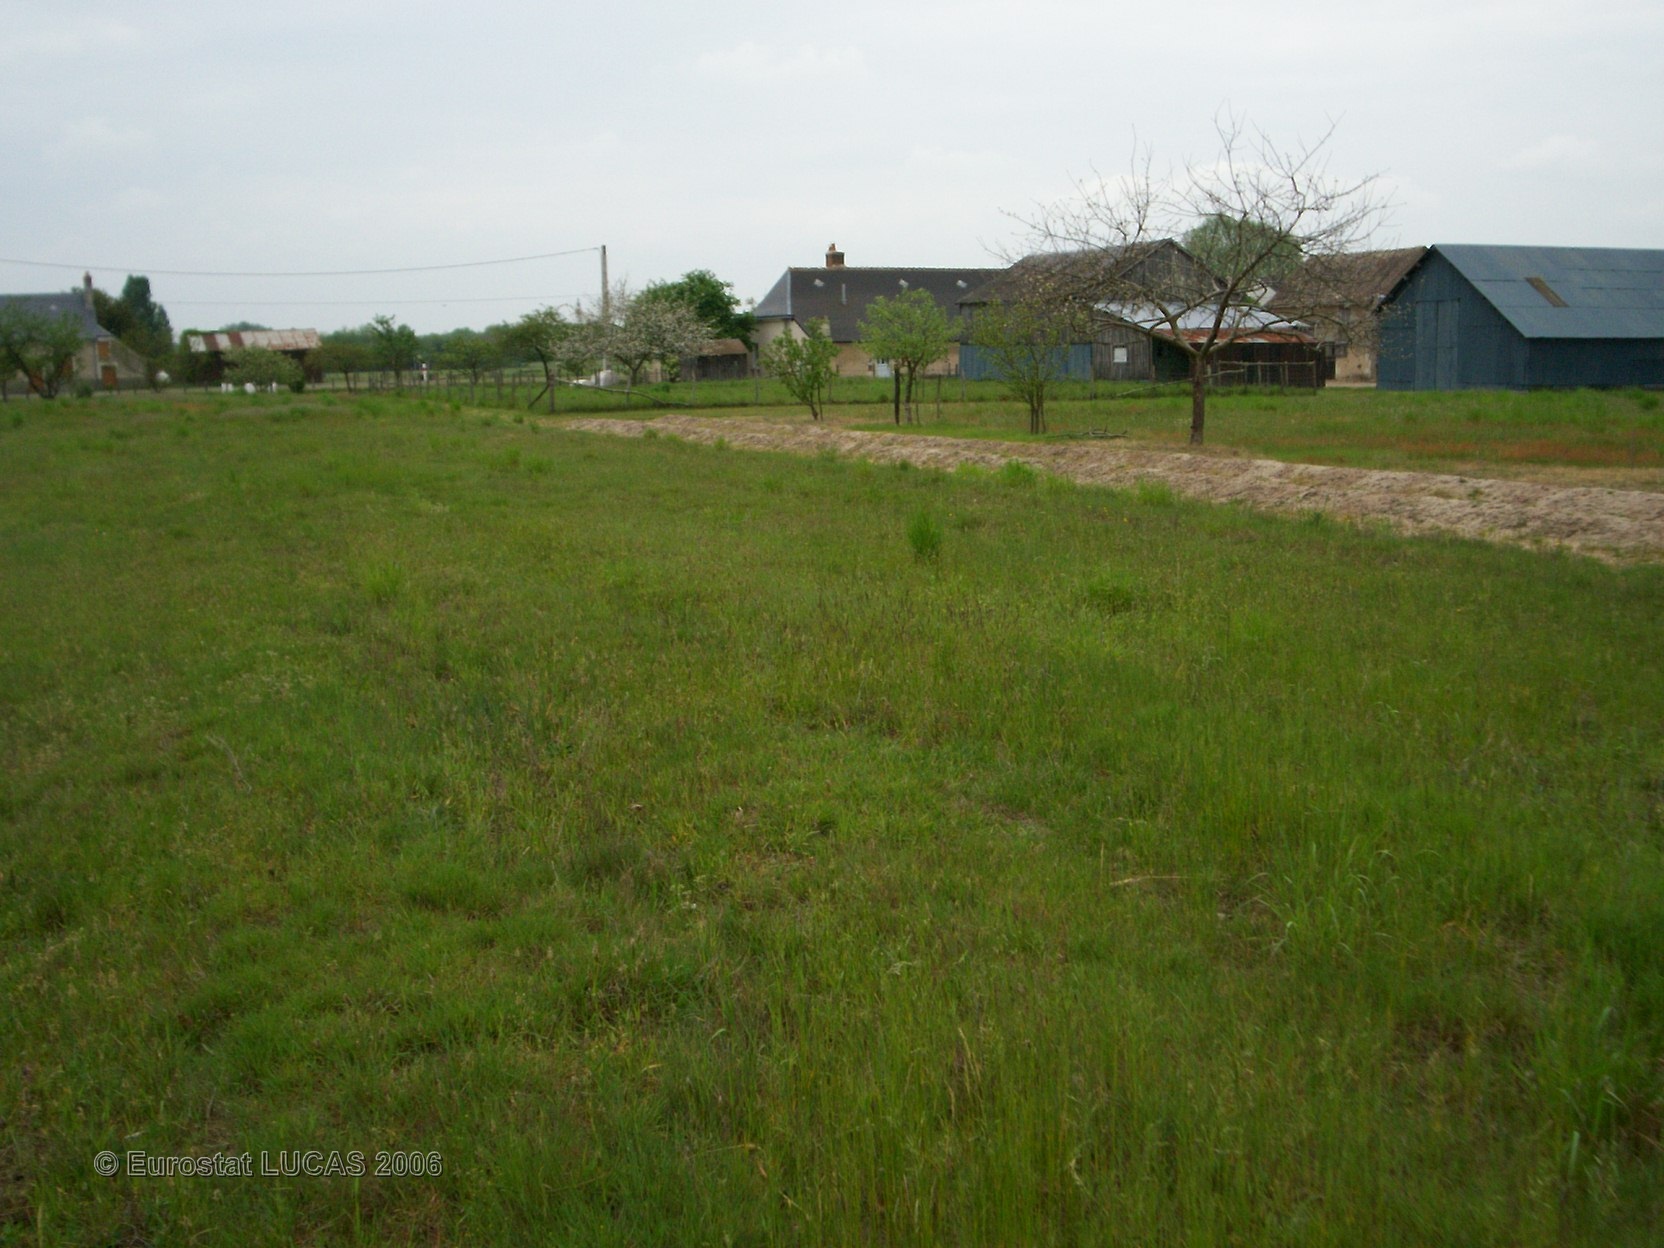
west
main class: Grassland
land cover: Grassland without tree/shrub cover
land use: Agriculture (excluding fallow land and kitchen gardens)
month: May
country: FR
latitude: 47.4226
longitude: 0.3940
